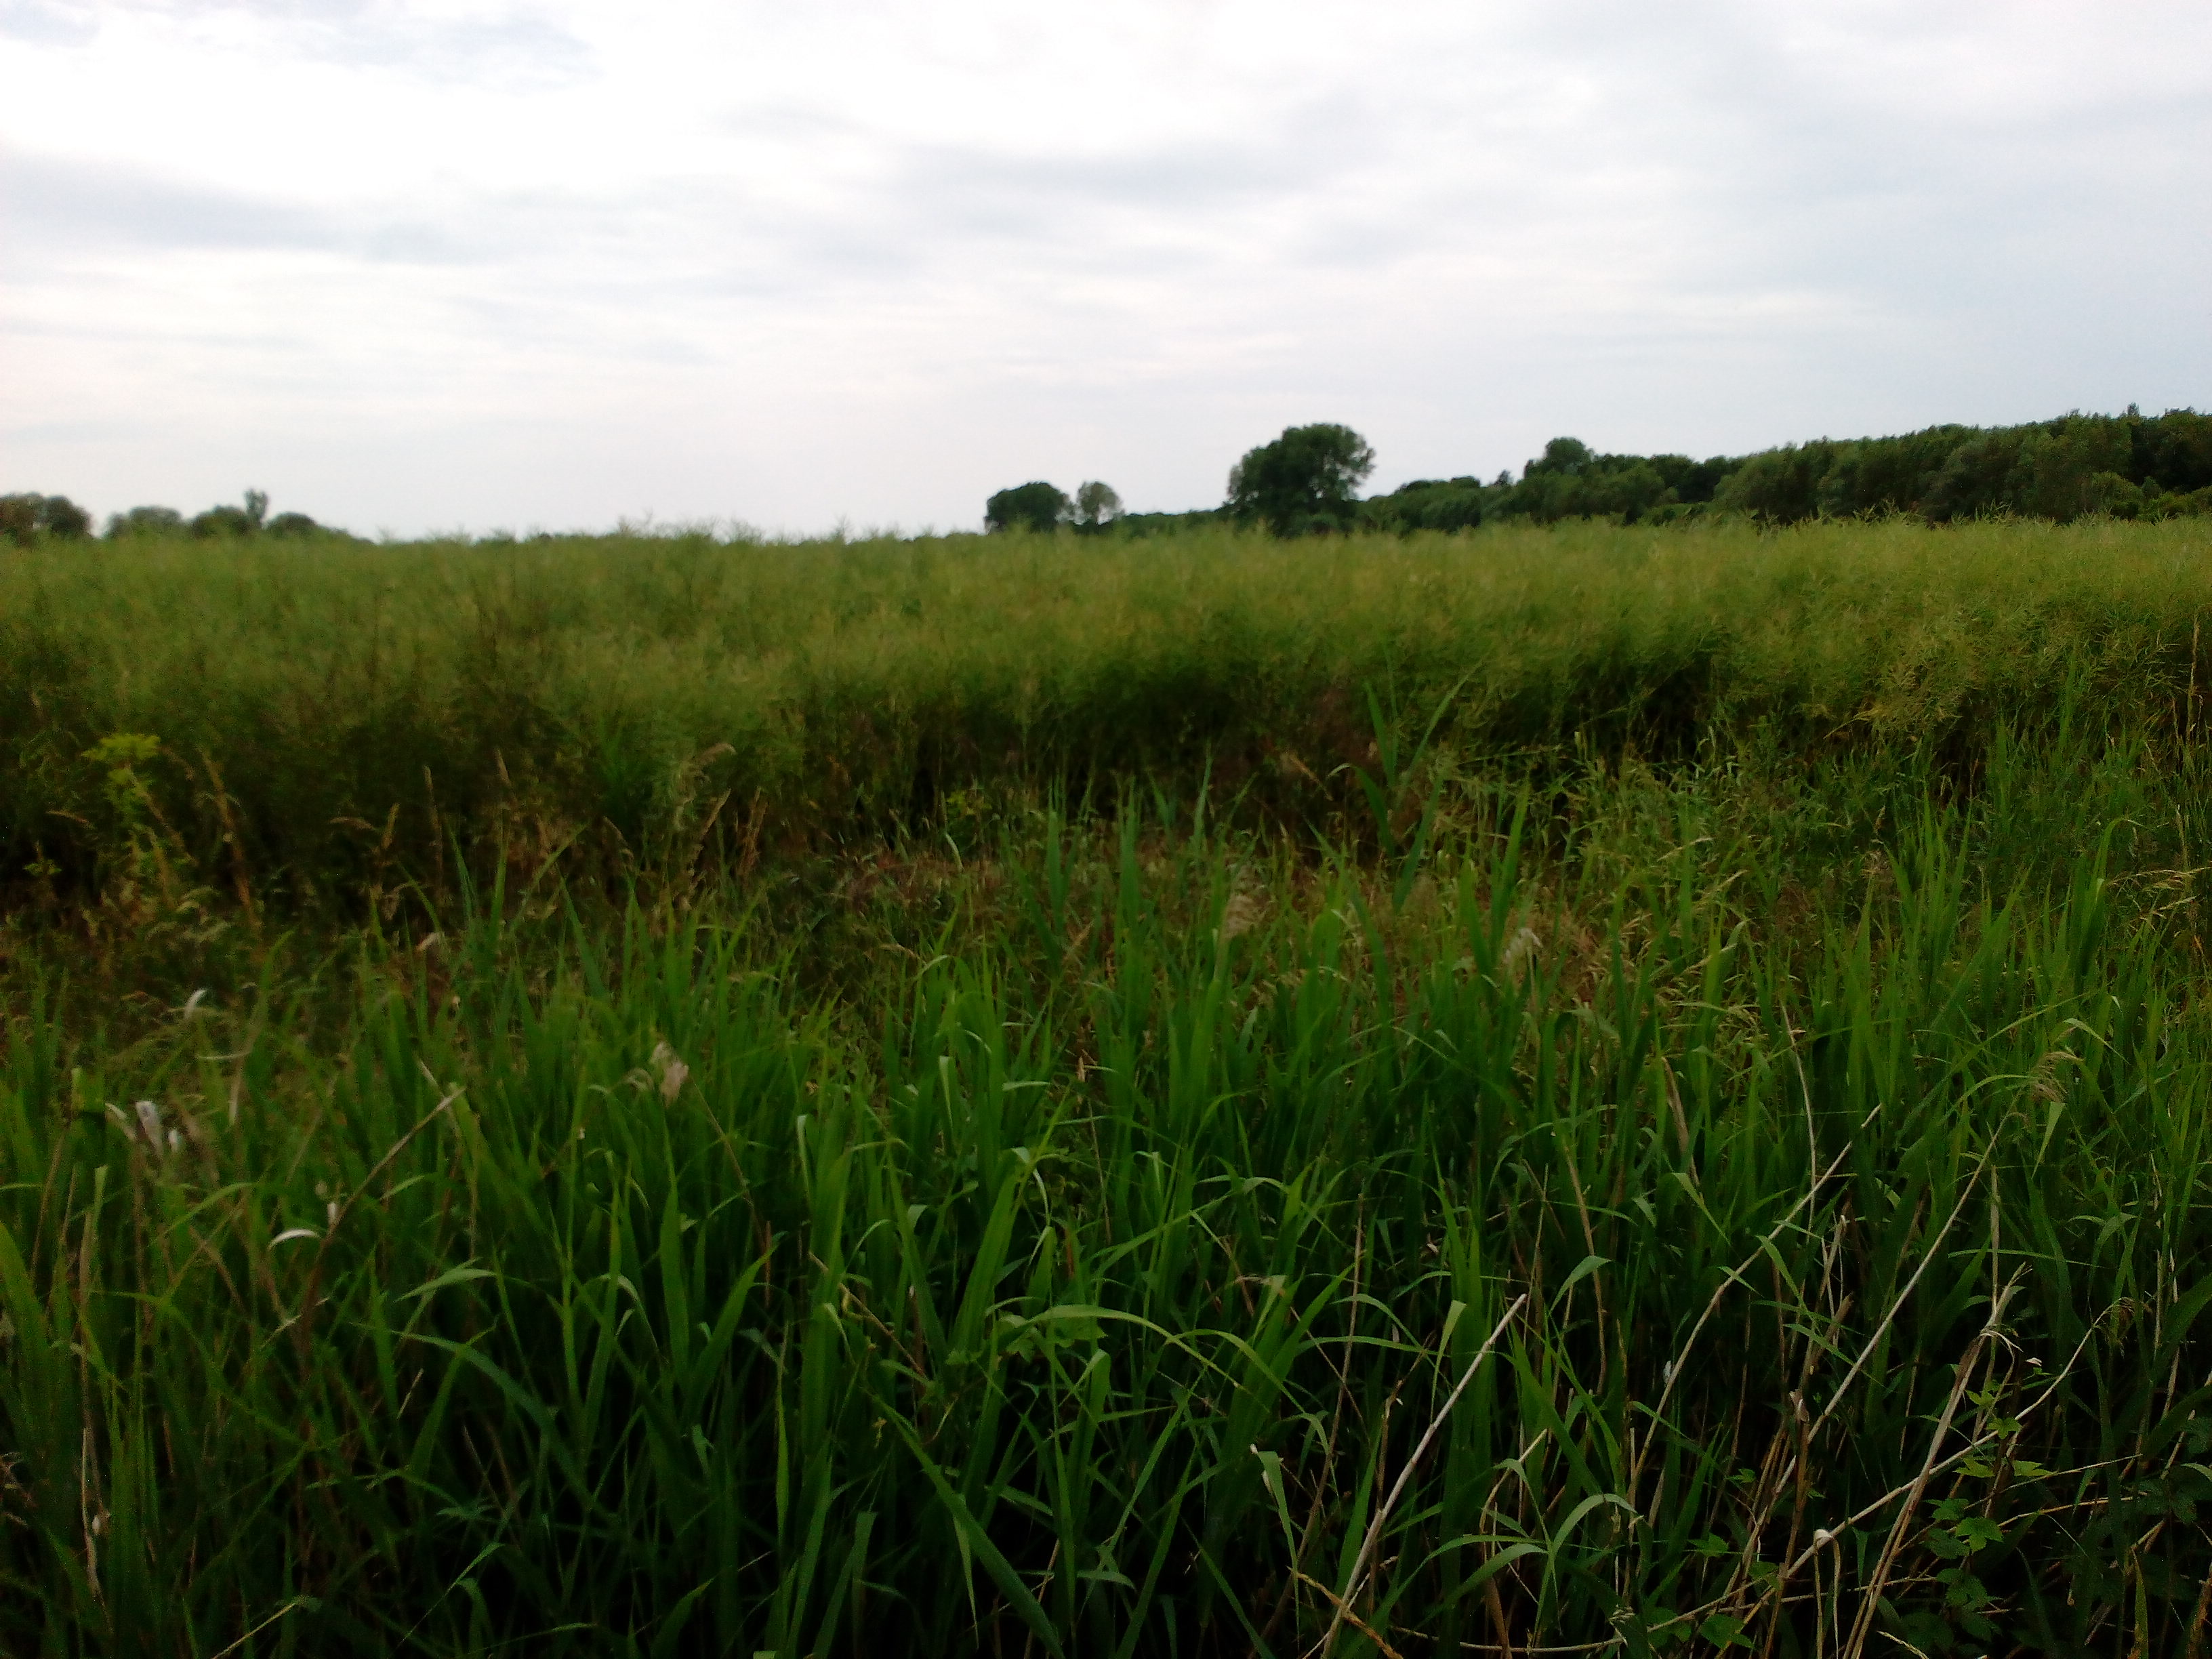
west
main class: Cropland
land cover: Rape and turnip rape
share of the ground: > 75 %
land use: Agriculture (excluding fallow land and kitchen gardens)
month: June
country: DE
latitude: 51.2226
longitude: 11.0163
